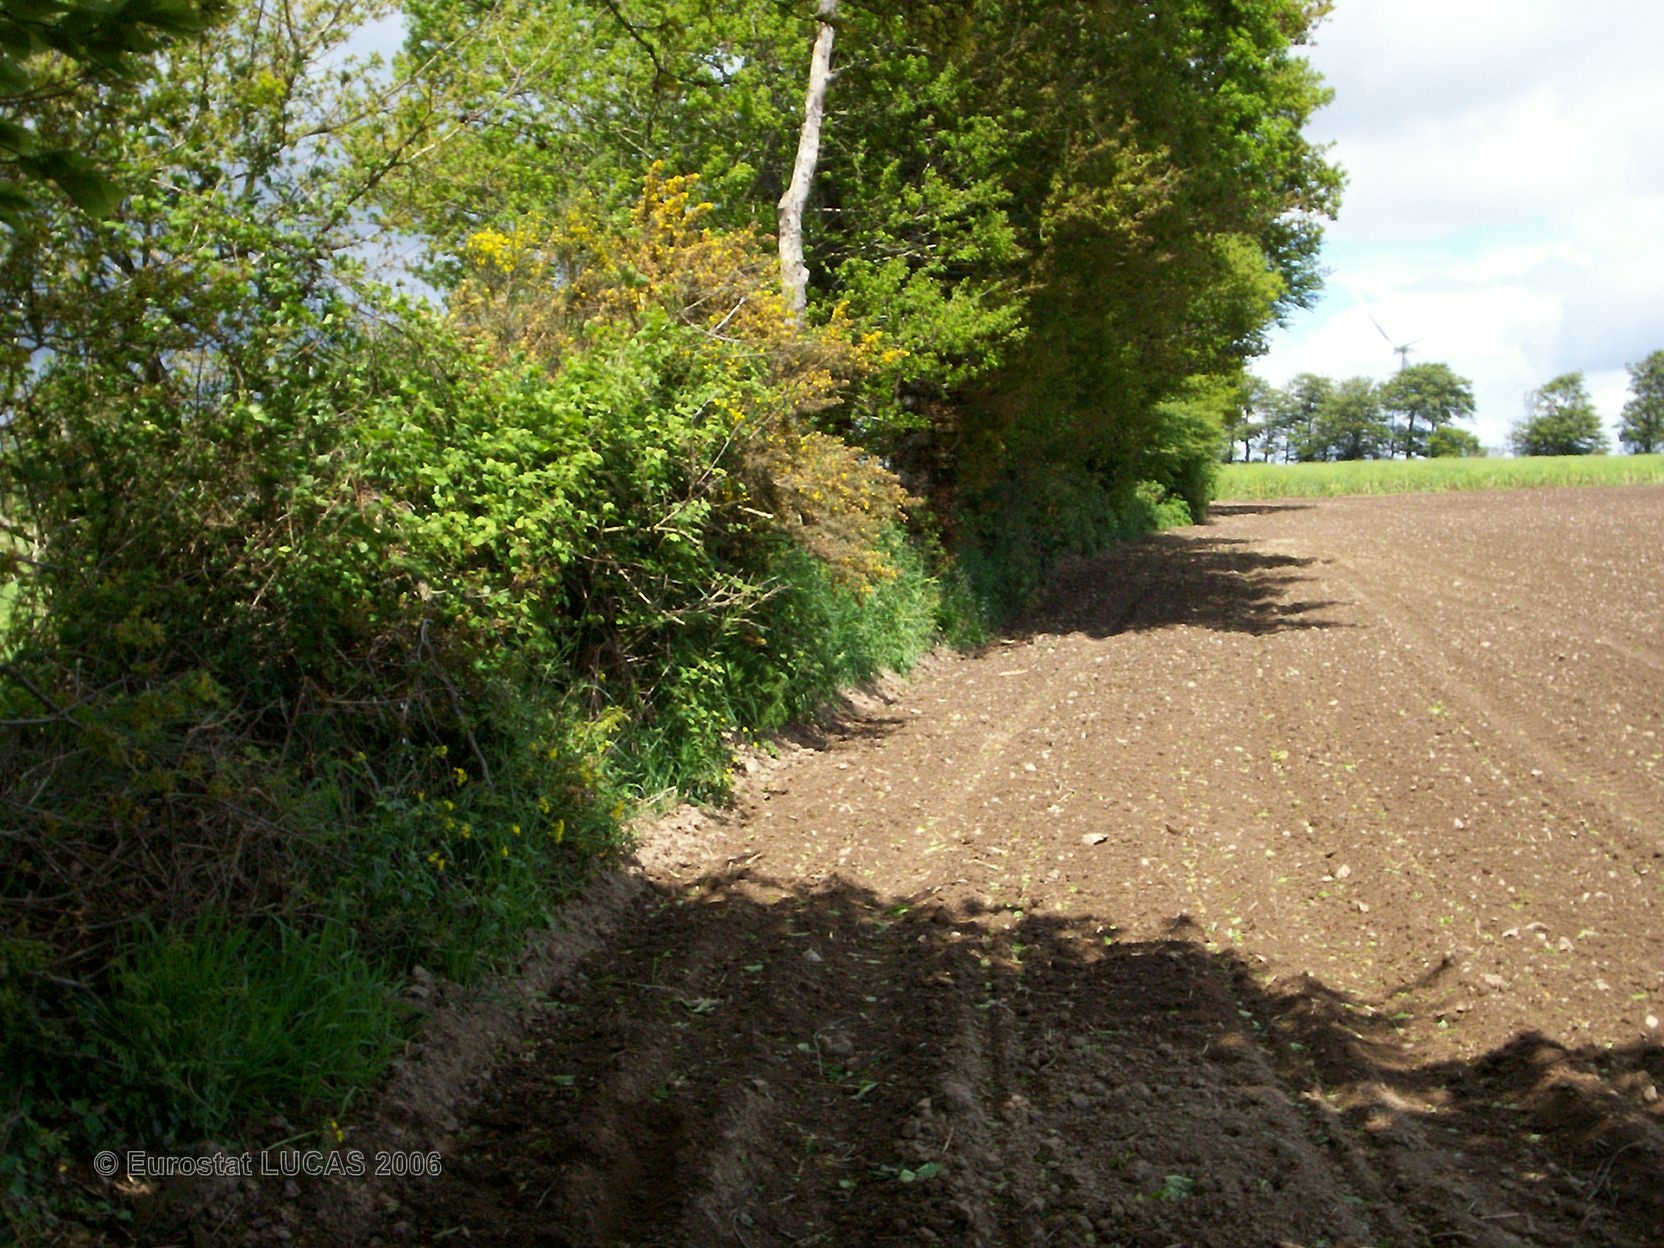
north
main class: Cropland
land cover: Maize
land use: Agriculture (excluding fallow land and kitchen gardens)
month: June
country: FR
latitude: 48.3512
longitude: -2.9282
